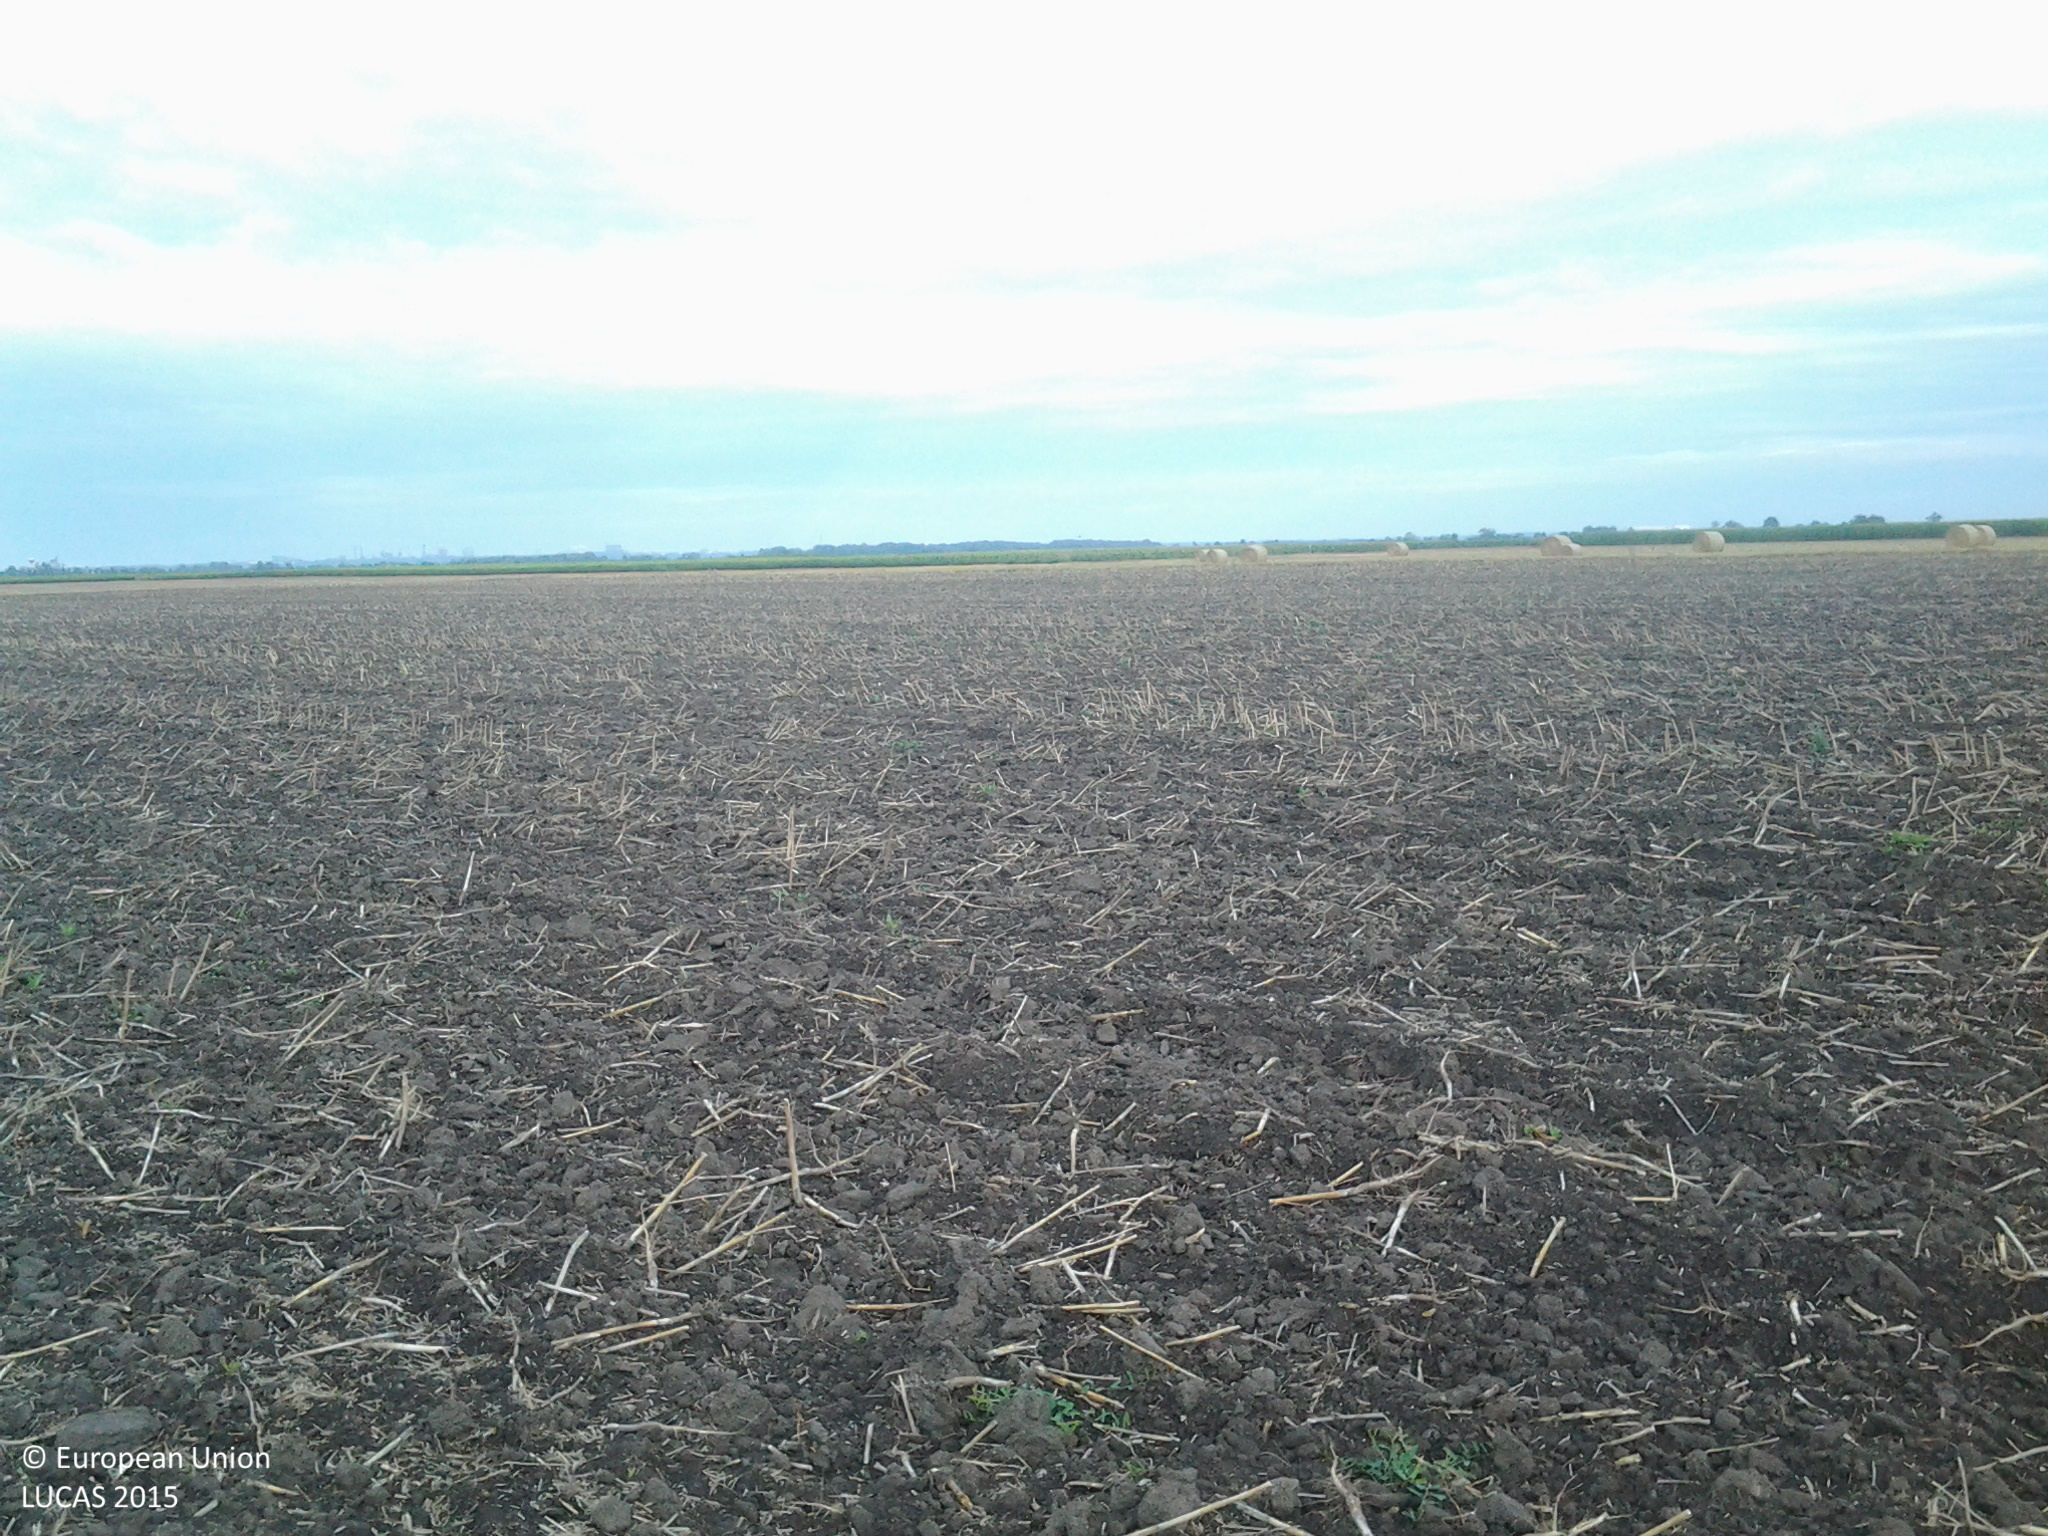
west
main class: Cropland
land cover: Rape and turnip rape
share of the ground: < 10 %
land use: Agriculture (excluding fallow land and kitchen gardens)
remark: Harvested field
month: July
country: HU
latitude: 46.9794
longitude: 19.0737
